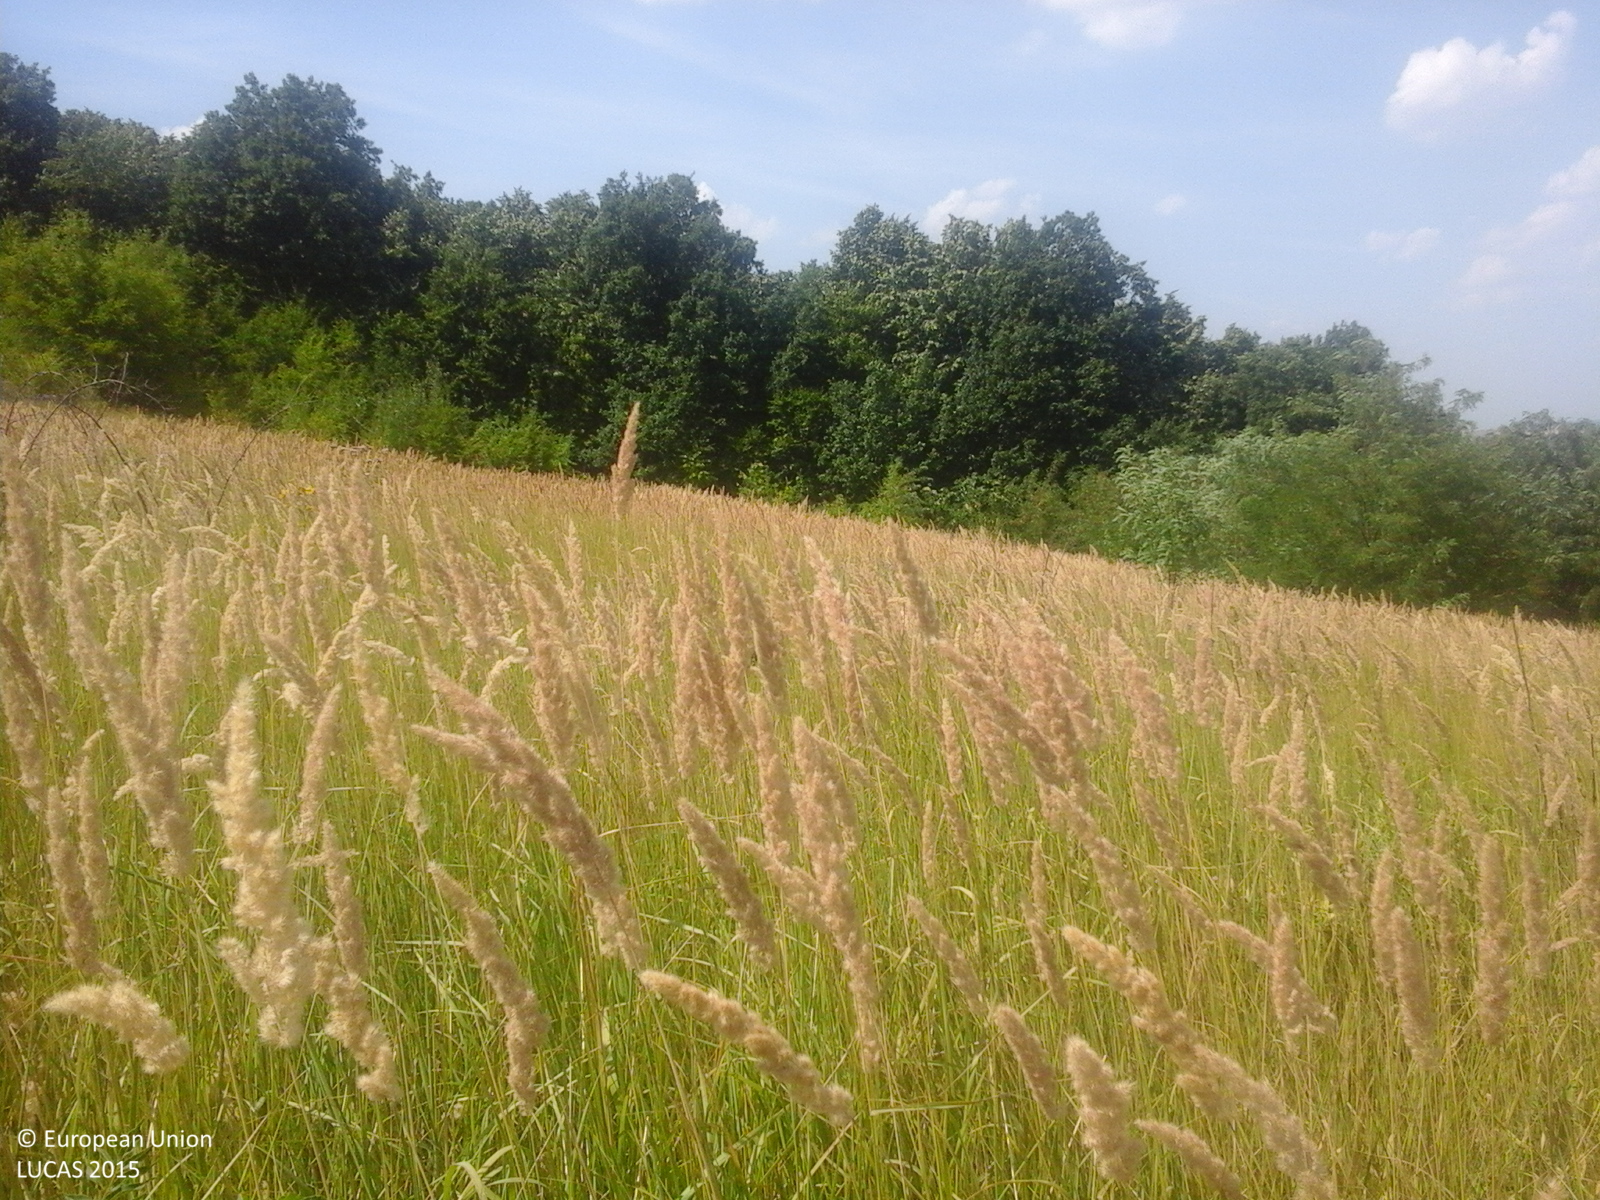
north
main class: Grassland
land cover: Spontaneously vegetated surfaces
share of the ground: > 75 %
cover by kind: herbaceous plants 100 %
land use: Fallow land
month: July
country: RO
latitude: 46.6662
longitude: 28.0215
